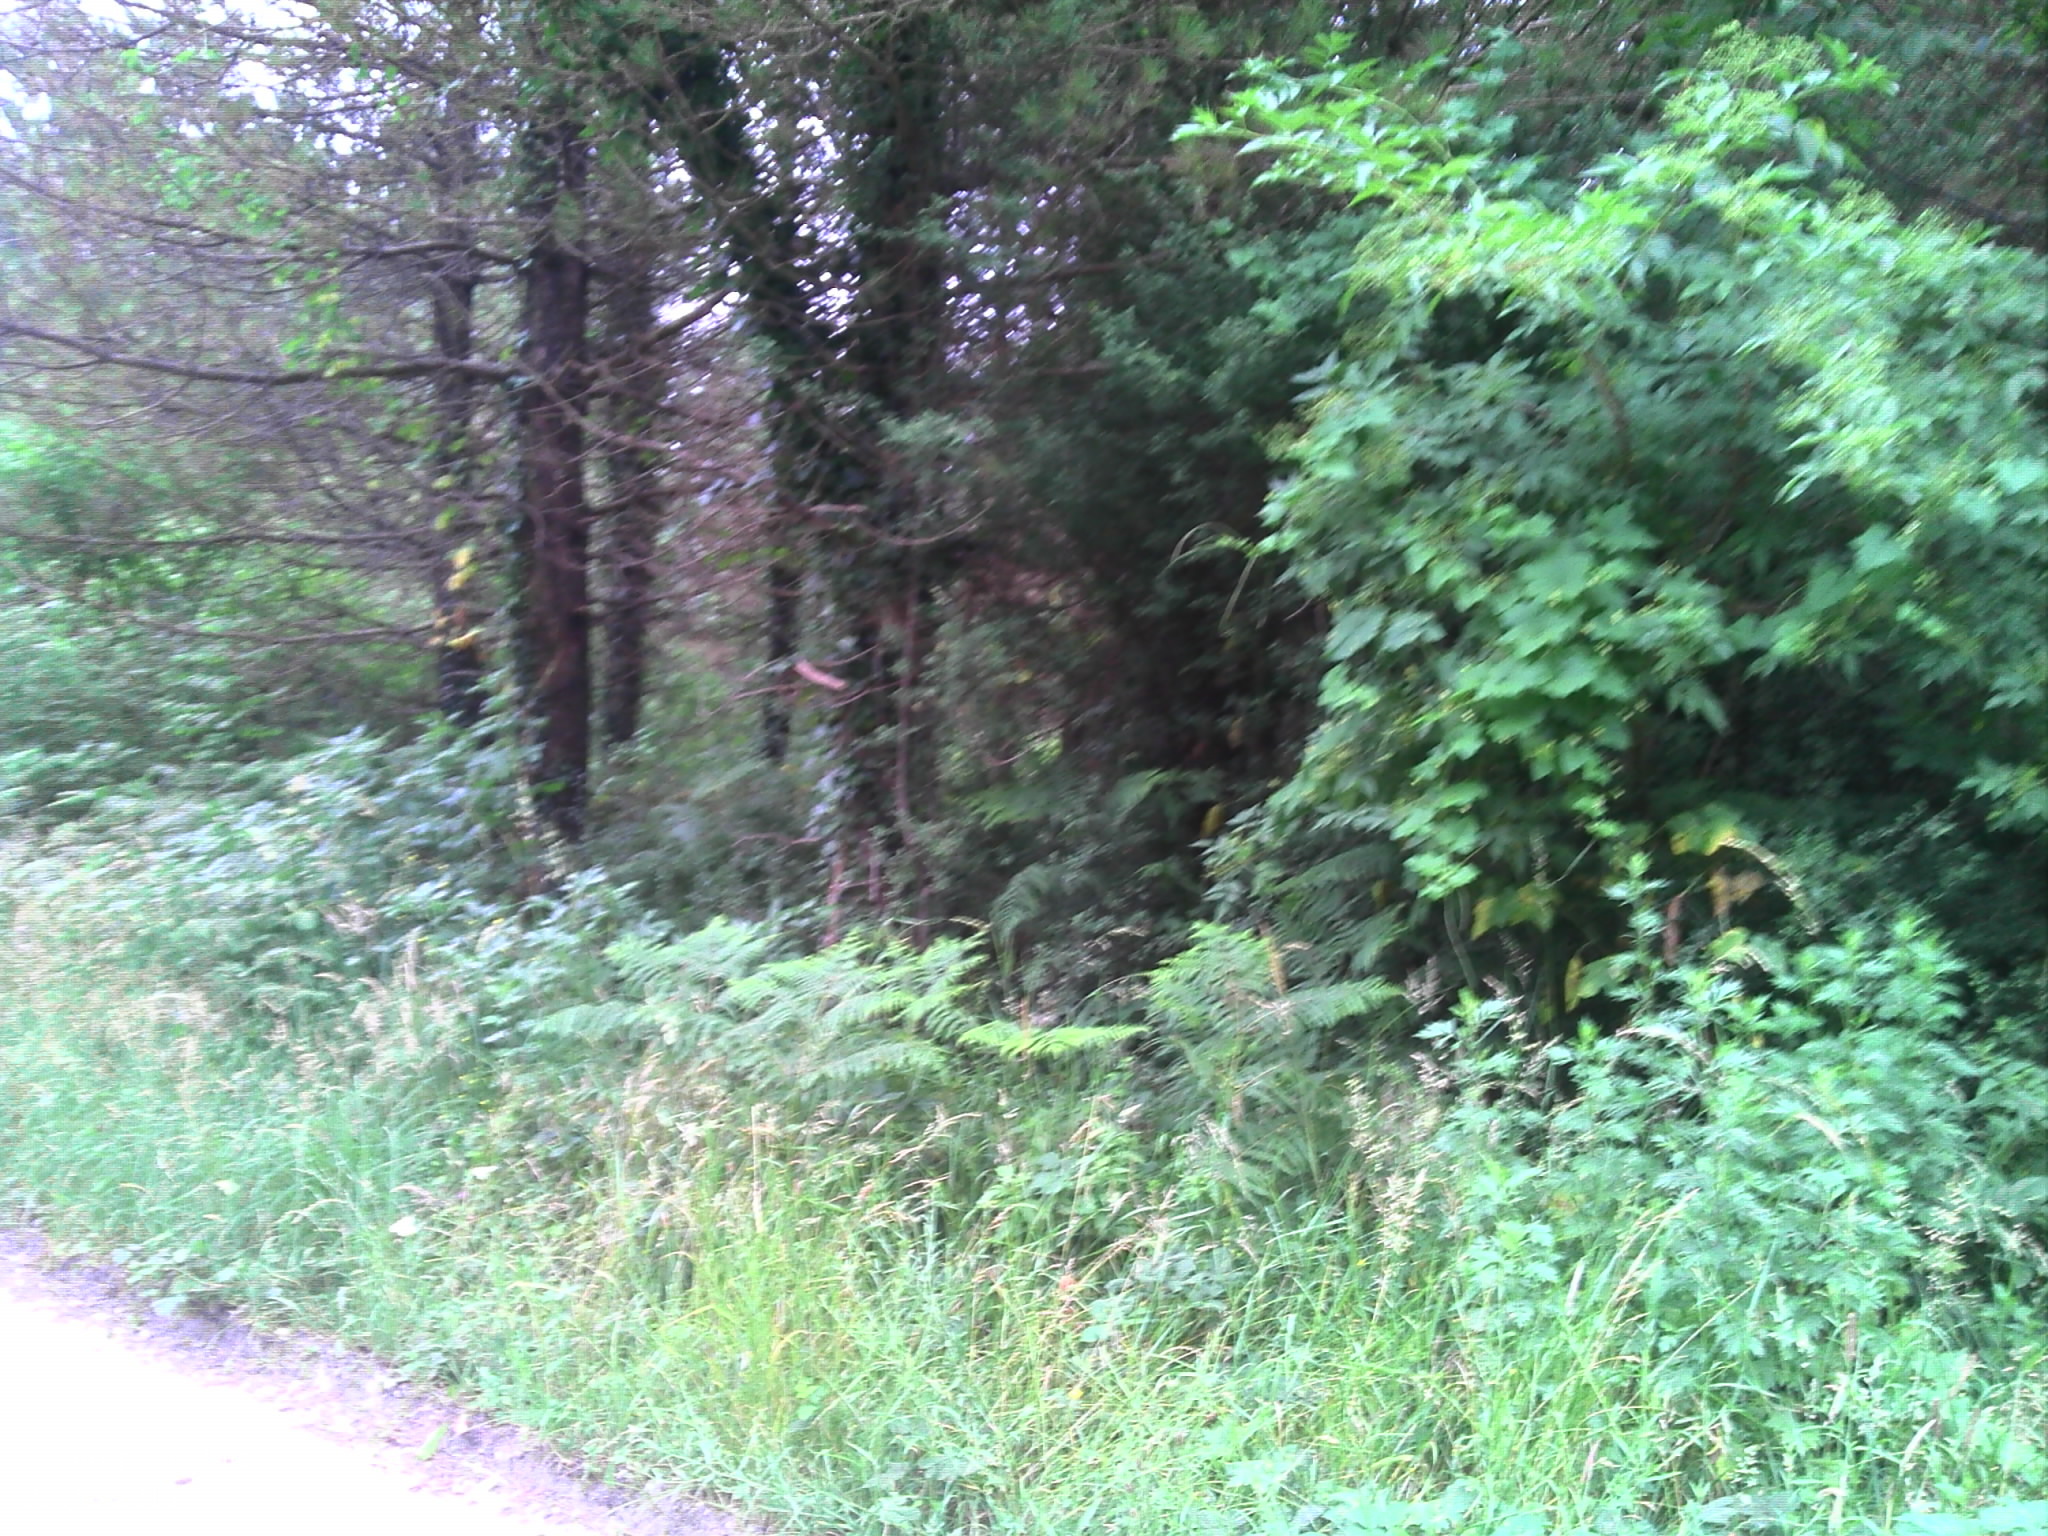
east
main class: Woodland
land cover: Pine dominated coniferous woodland
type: coniferous forest of the mediterranean region
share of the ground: > 75 %
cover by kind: coniferous forest trees 100 %
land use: Forestry
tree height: > 5 m
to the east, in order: Pine dominated coniferous woodland; Abandoned hedges; Grass margins; Tracks; Grass margins; Pine dominated mixed woodland; Tracks; Pine dominated mixed woodland
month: June
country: FR
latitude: 43.4103
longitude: 2.0408
